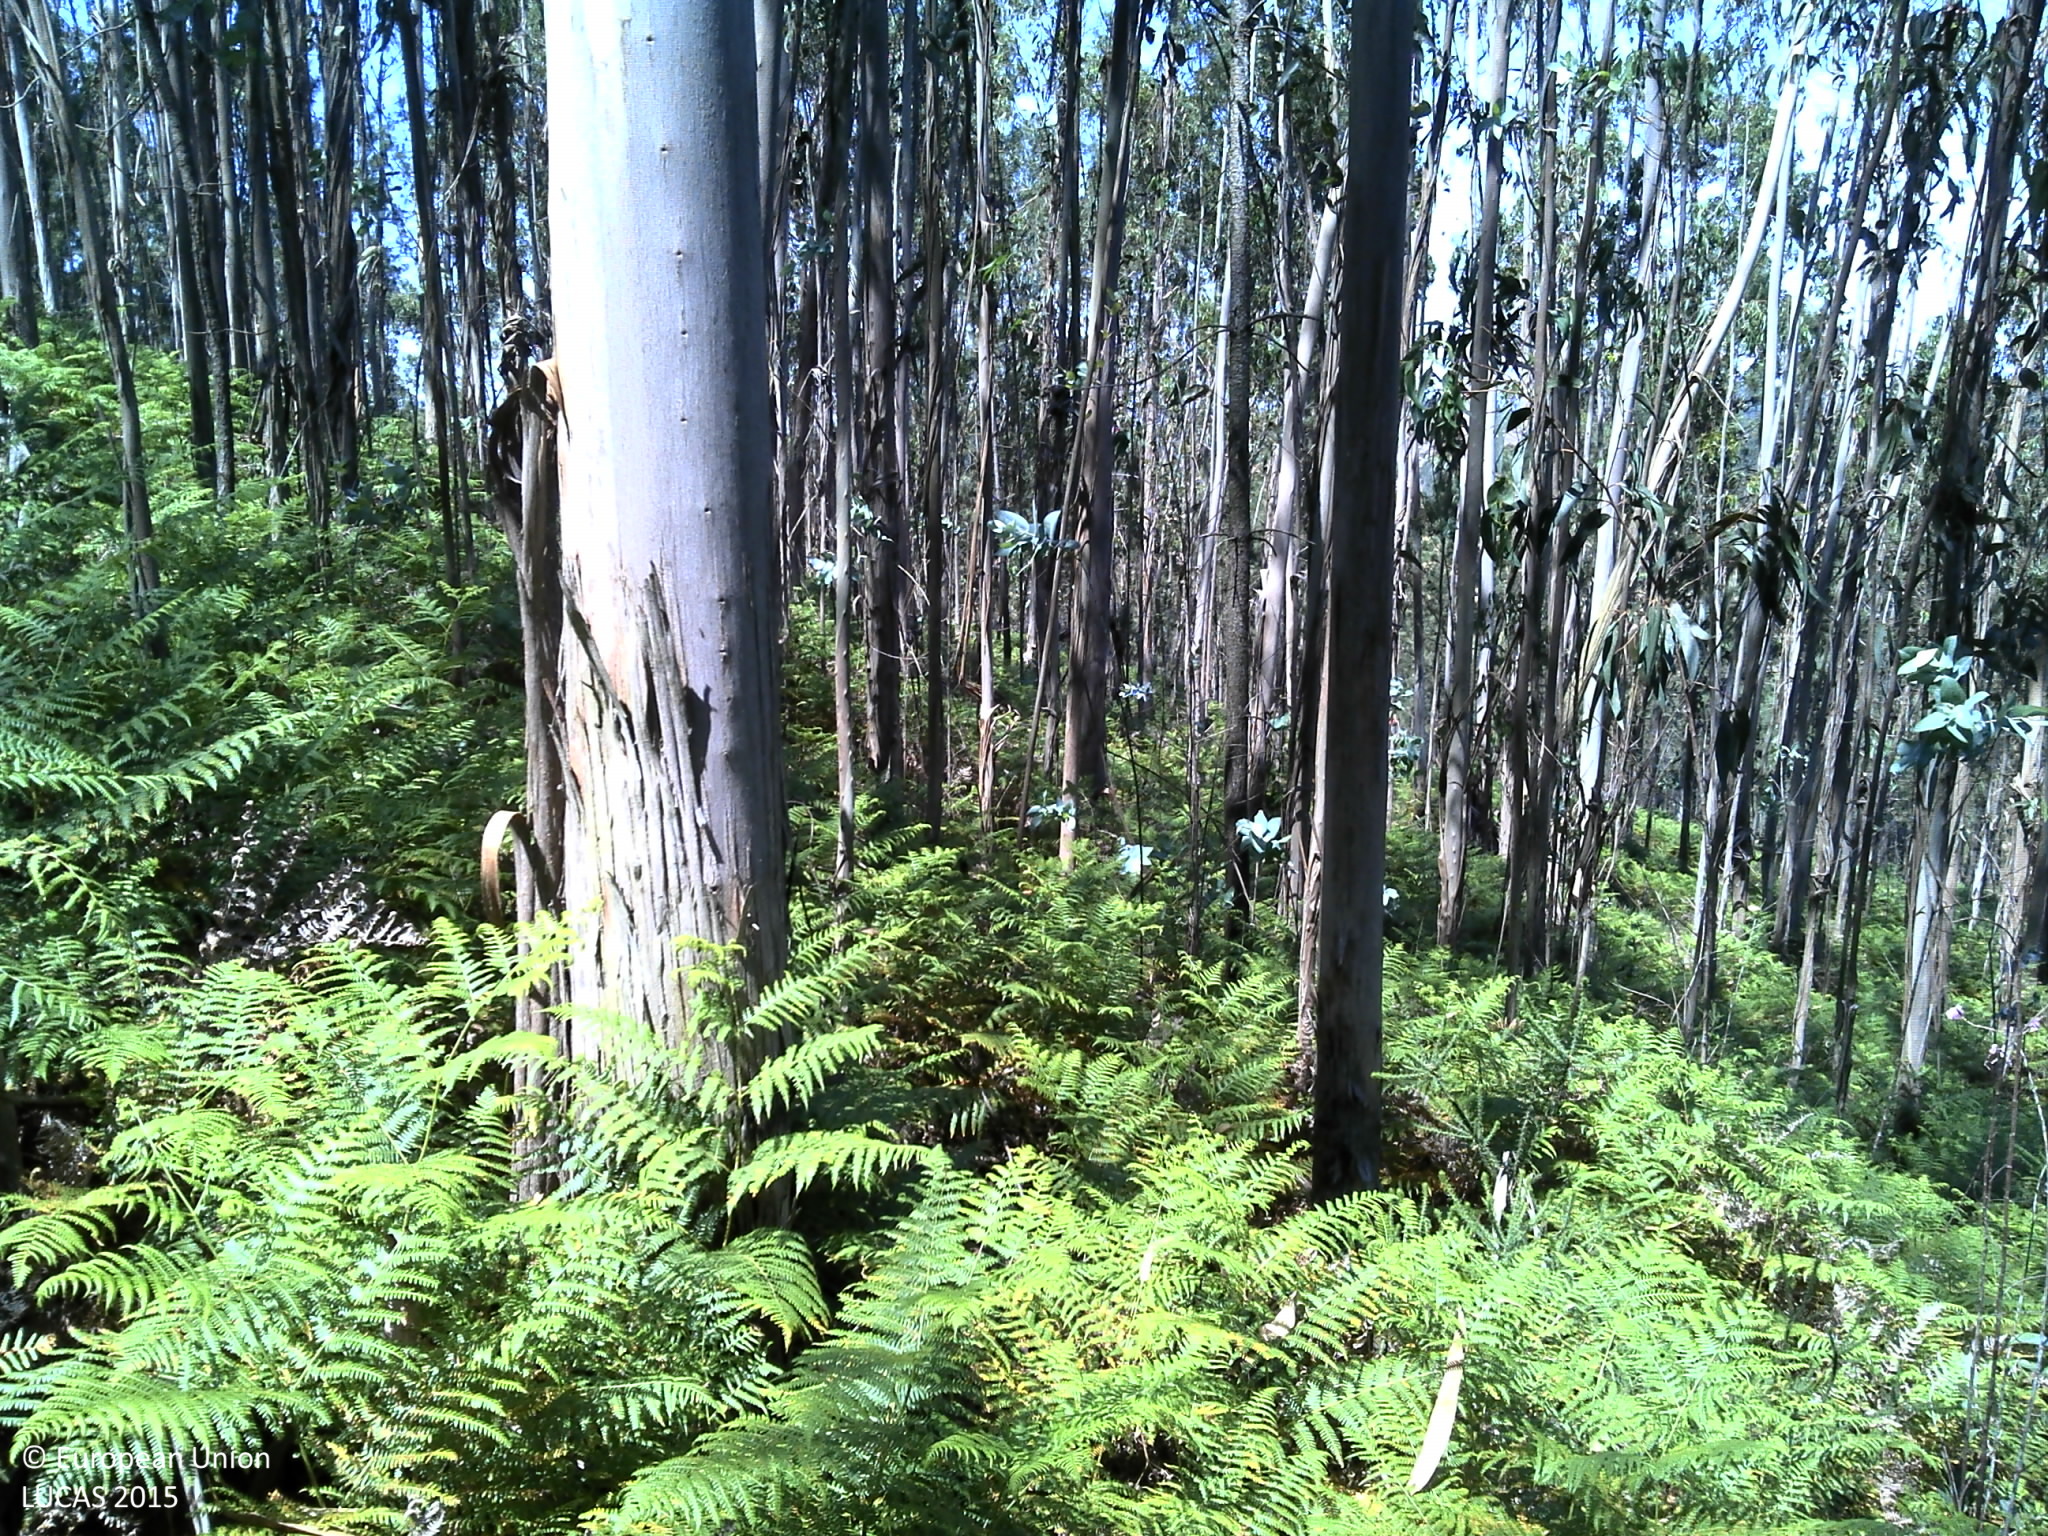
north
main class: Woodland
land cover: Broadleaved woodland
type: exotic forest
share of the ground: 25 - 50 %
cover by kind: broadleaved forest trees 50 %, shrubs 30 %, unconsolidated bare surface 20 %
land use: Forestry
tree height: > 5 m
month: May
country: PT
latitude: 41.3698
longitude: -8.6282
